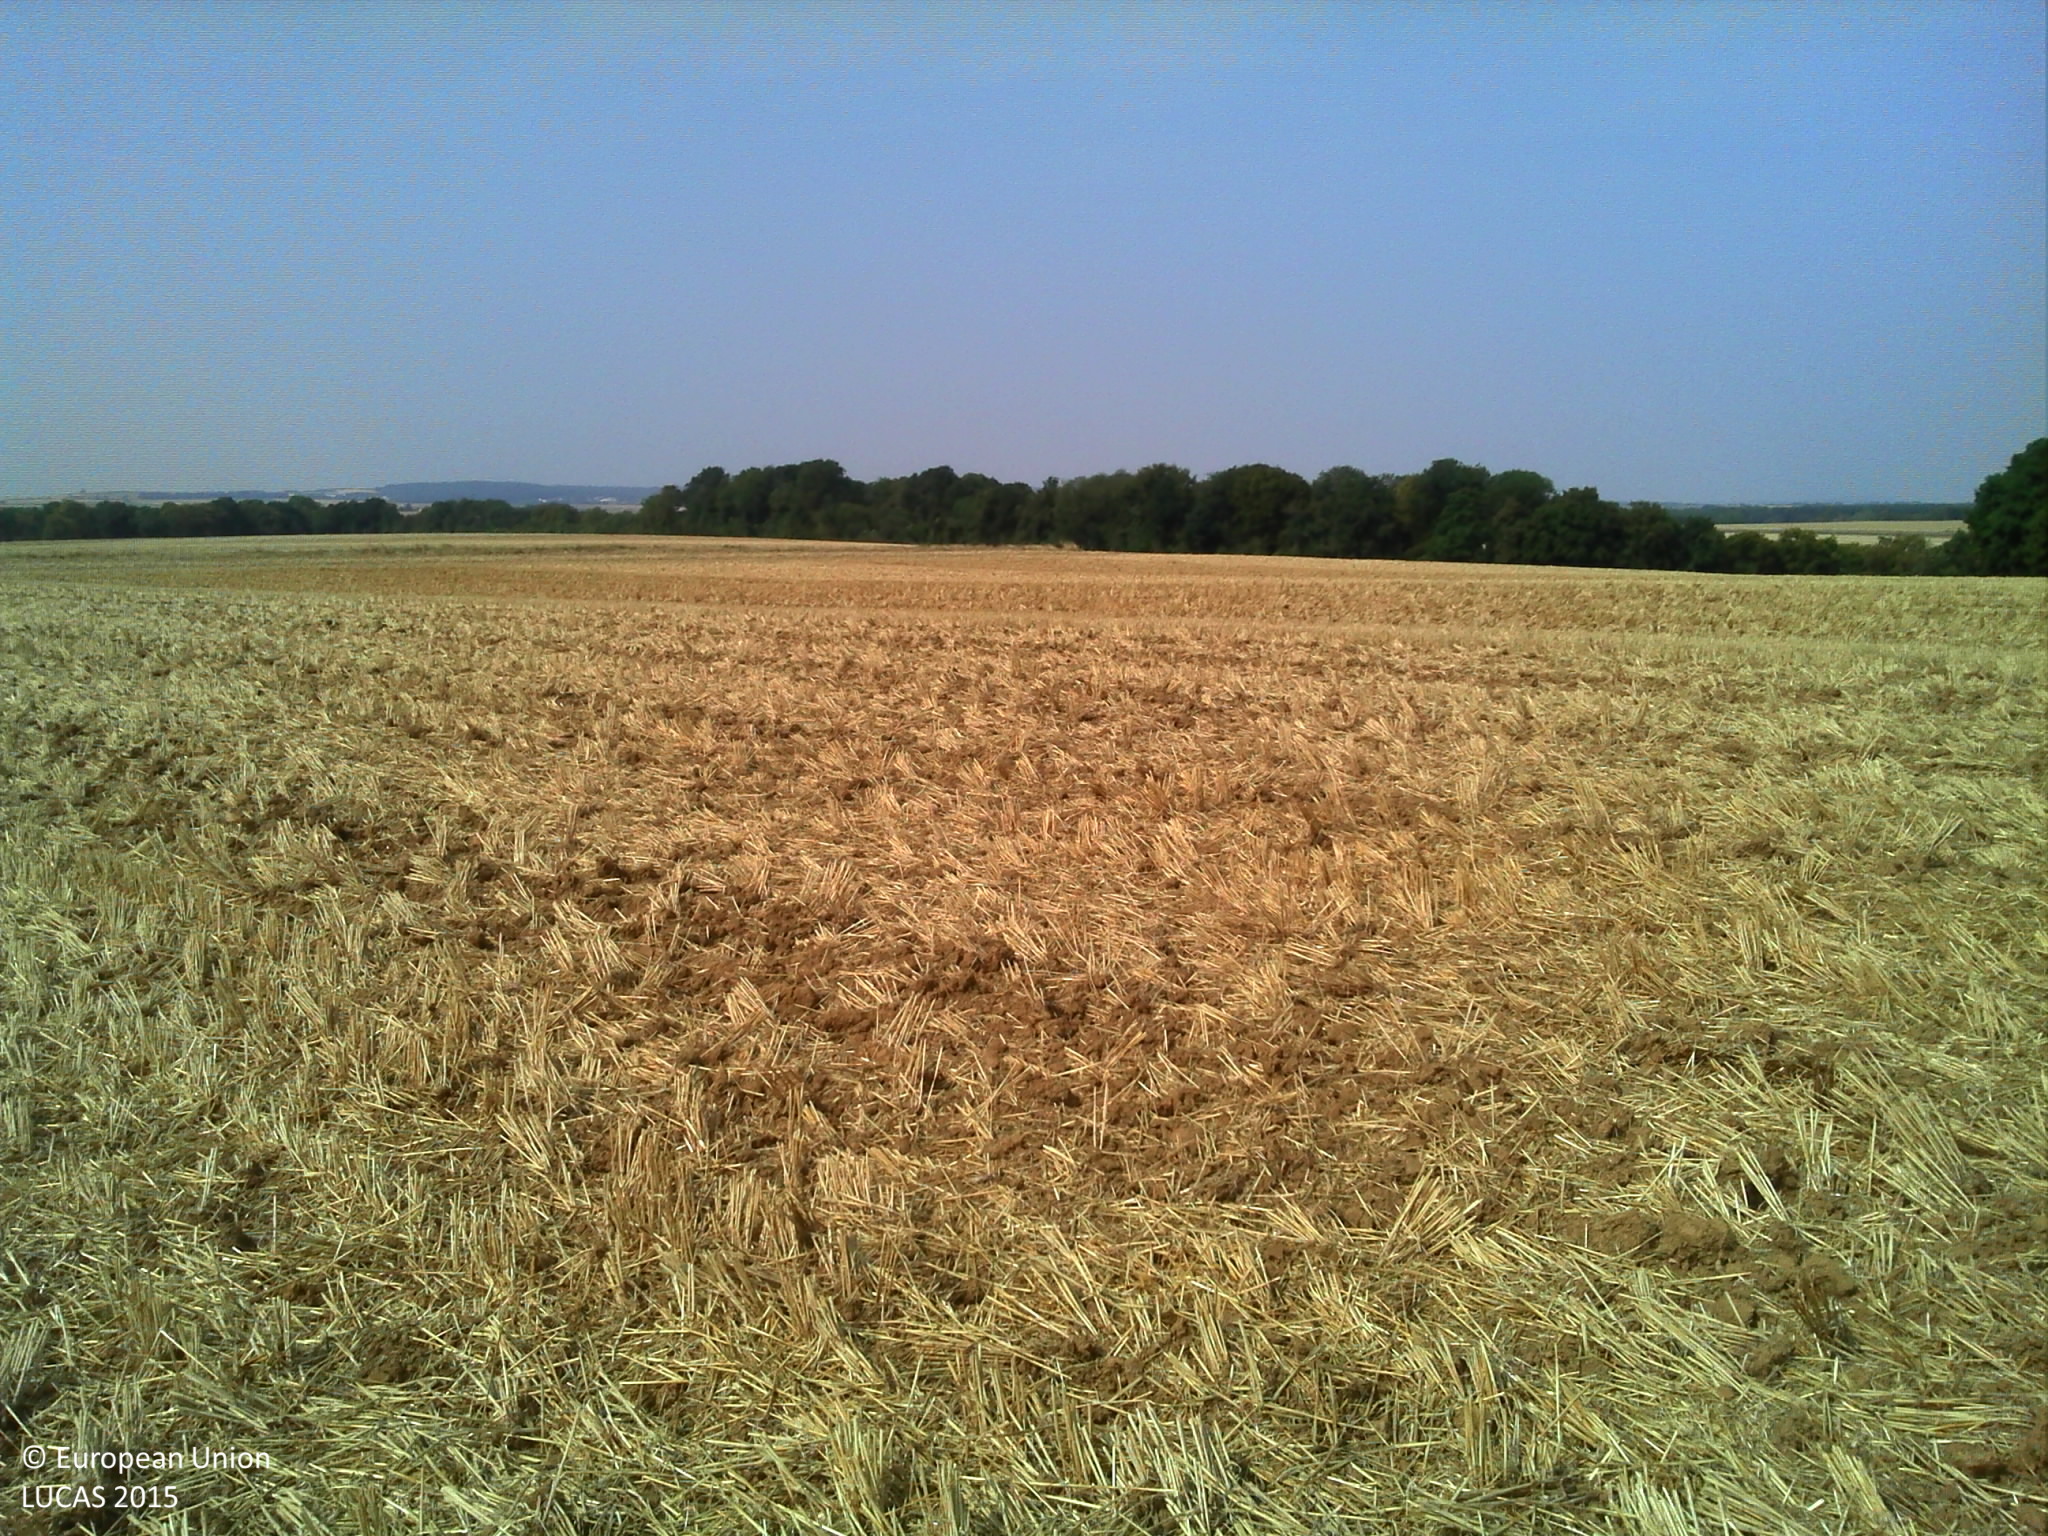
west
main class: Cropland
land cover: Common wheat
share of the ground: > 75 %
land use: Agriculture (excluding fallow land and kitchen gardens)
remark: Harvested field
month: August
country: FR
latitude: 49.0593
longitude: 2.8879
